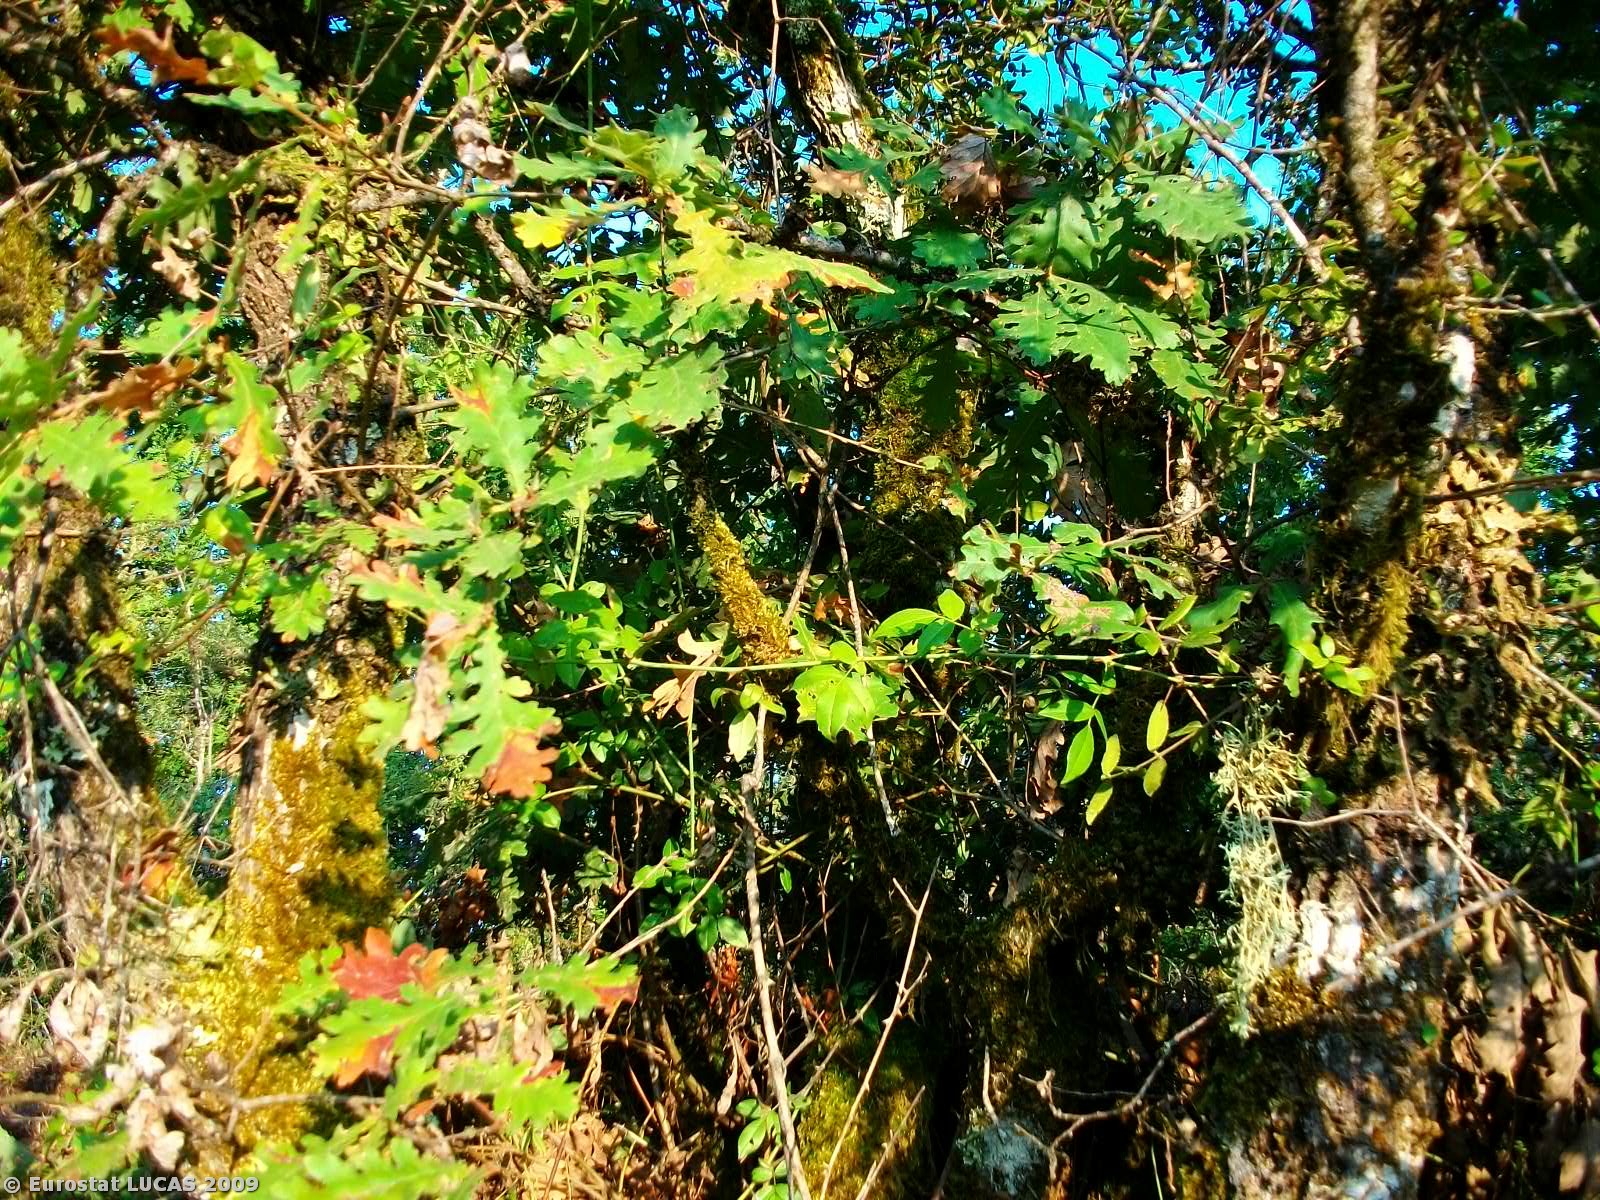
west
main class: Woodland
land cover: Broadleaved woodland
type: thermophilous deciduous forest
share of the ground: > 75 %
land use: Forestry
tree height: > 5 m
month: September
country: GR
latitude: 39.7039
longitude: 20.4853
